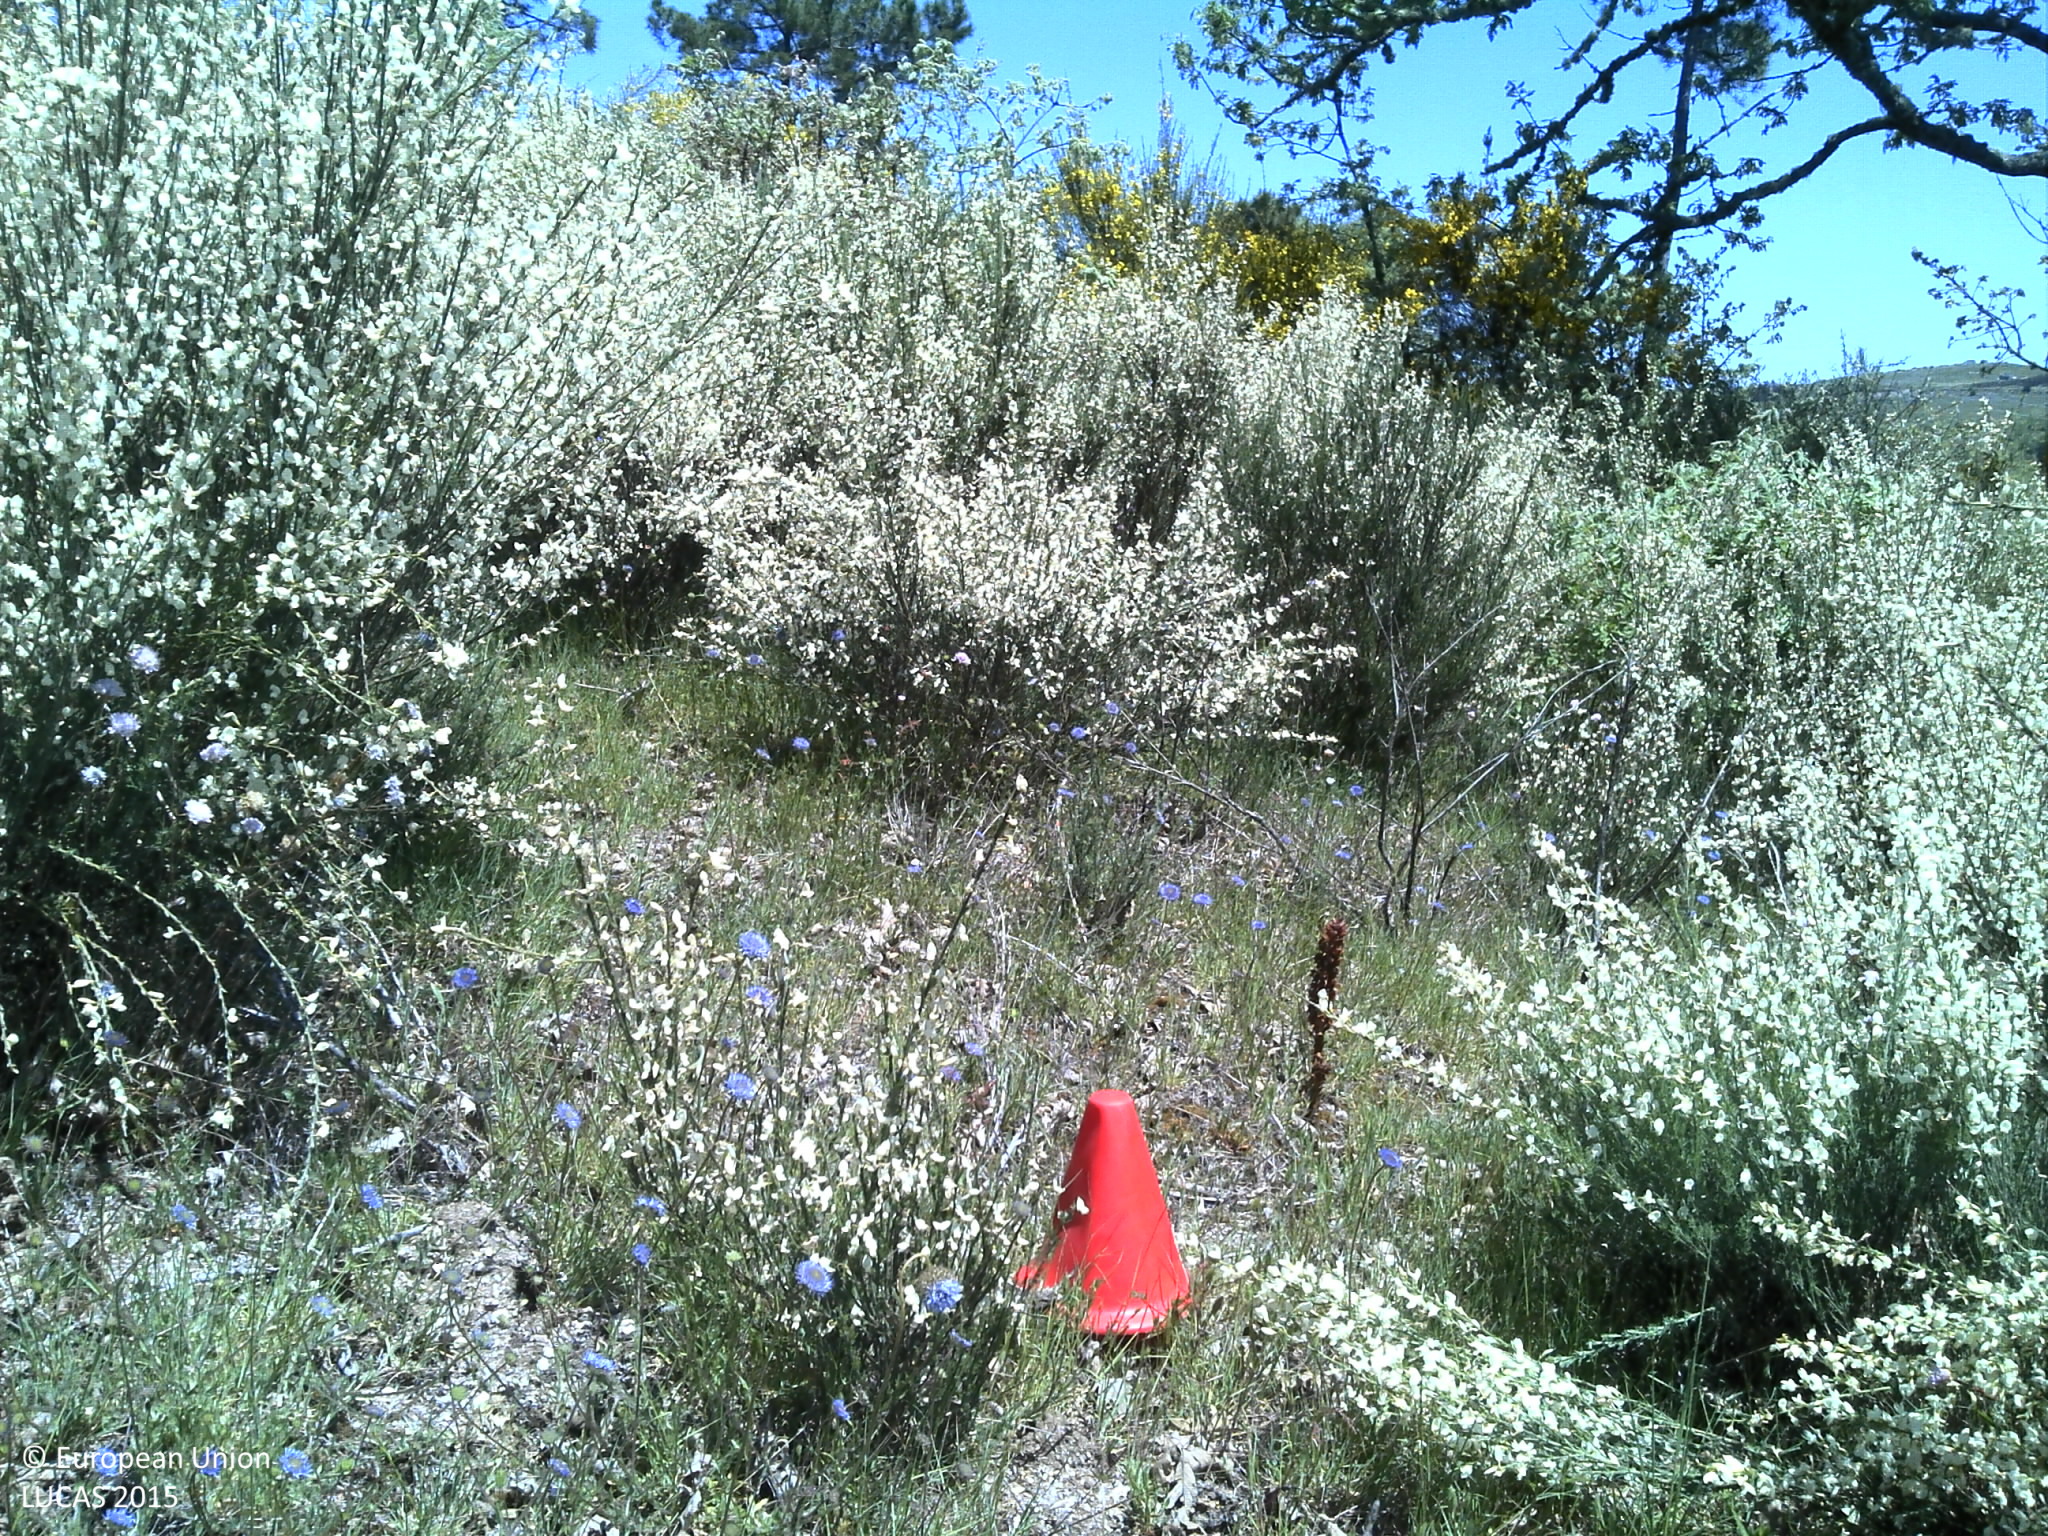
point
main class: Shrubland
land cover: Shrubland with sparse tree cover
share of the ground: 50 - 75 %
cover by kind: shrubs 75 %, unconsolidated bare surface 20 %, broadleaved forest trees 5 %
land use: Semi-natural and natural areas not in use
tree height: < 5 m
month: May
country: PT
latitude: 41.0279
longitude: -7.8870
